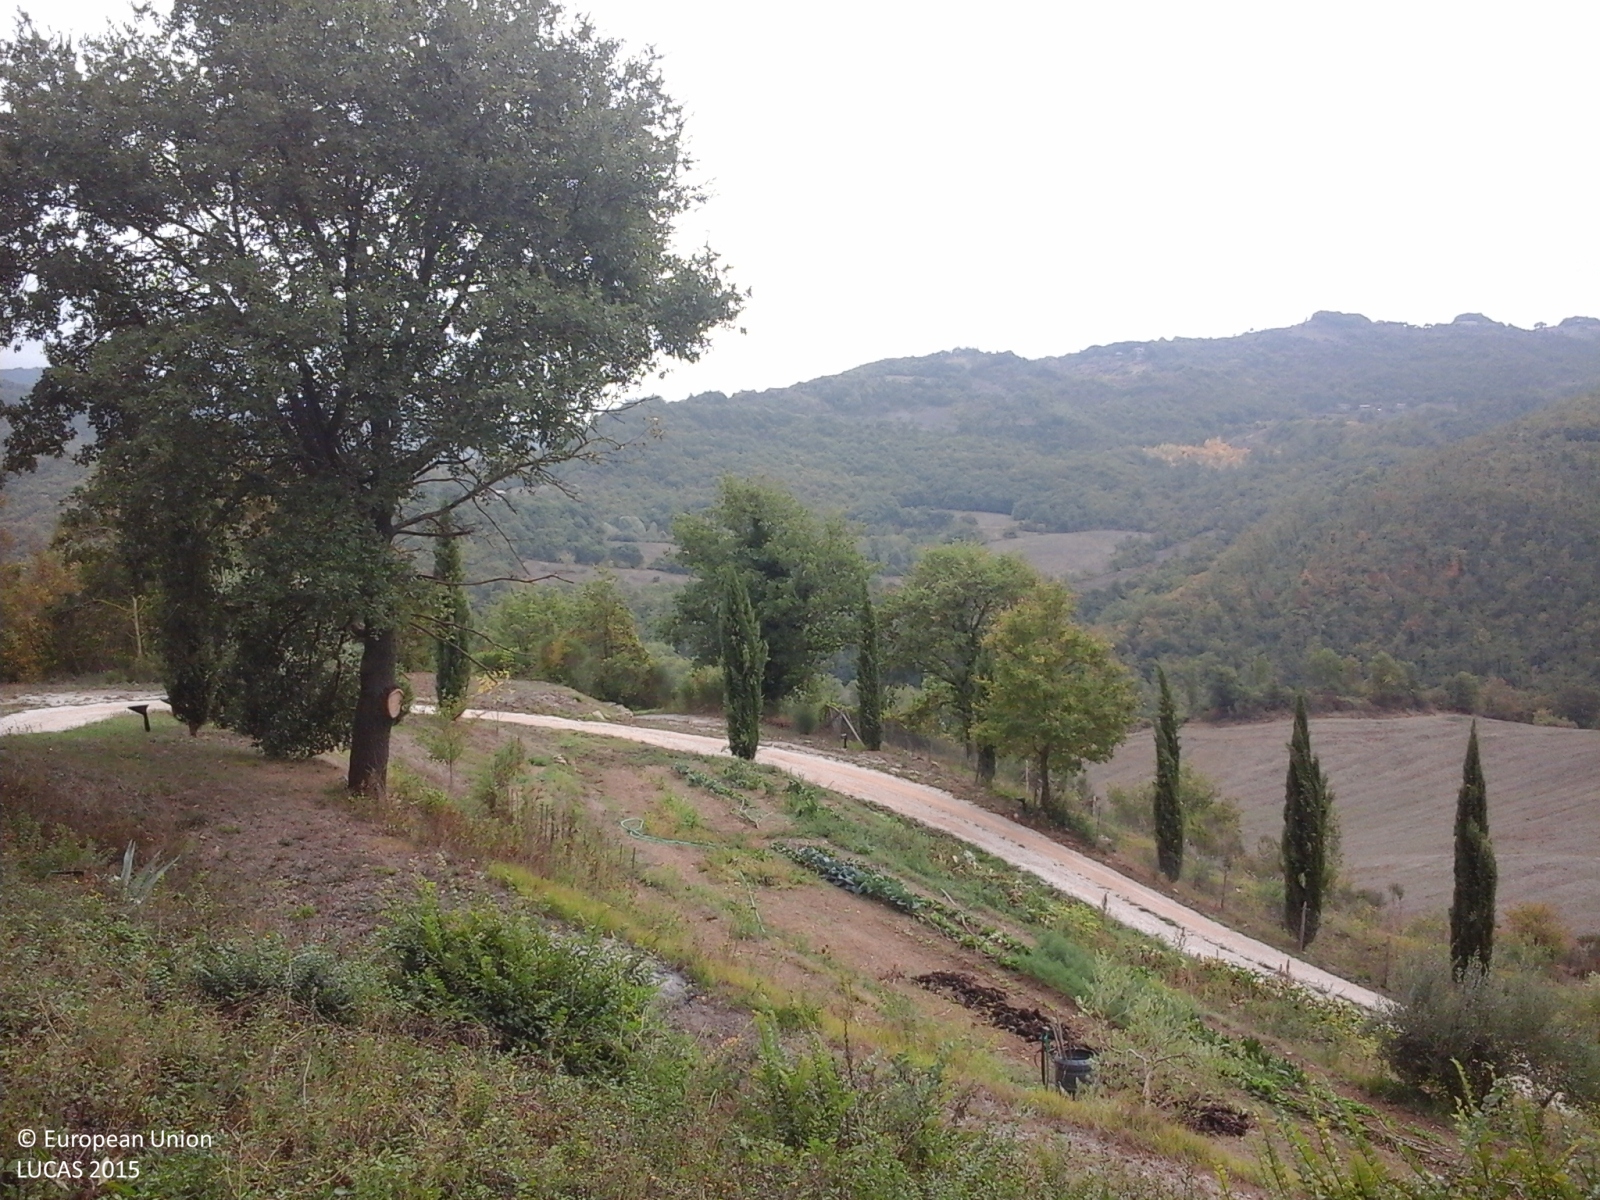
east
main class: Woodland
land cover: Broadleaved woodland
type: thermophilous deciduous forest
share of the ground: > 75 %
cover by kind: shrubs 40 %, broadleaved forest trees 35 %, herbaceous plants 25 %
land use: Forestry
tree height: < 5 m
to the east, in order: Broadleaved woodland; Lines of trees; Paved roads, cycling and walking lanes; Spontaneously vegetated surfaces; Broadleaved woodland; Tracks; Broadleaved woodland; Grassland without tree/shrub cover; Broadleaved woodland; Tracks; Other bare soil
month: October
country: IT
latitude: 43.3301
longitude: 12.3983
